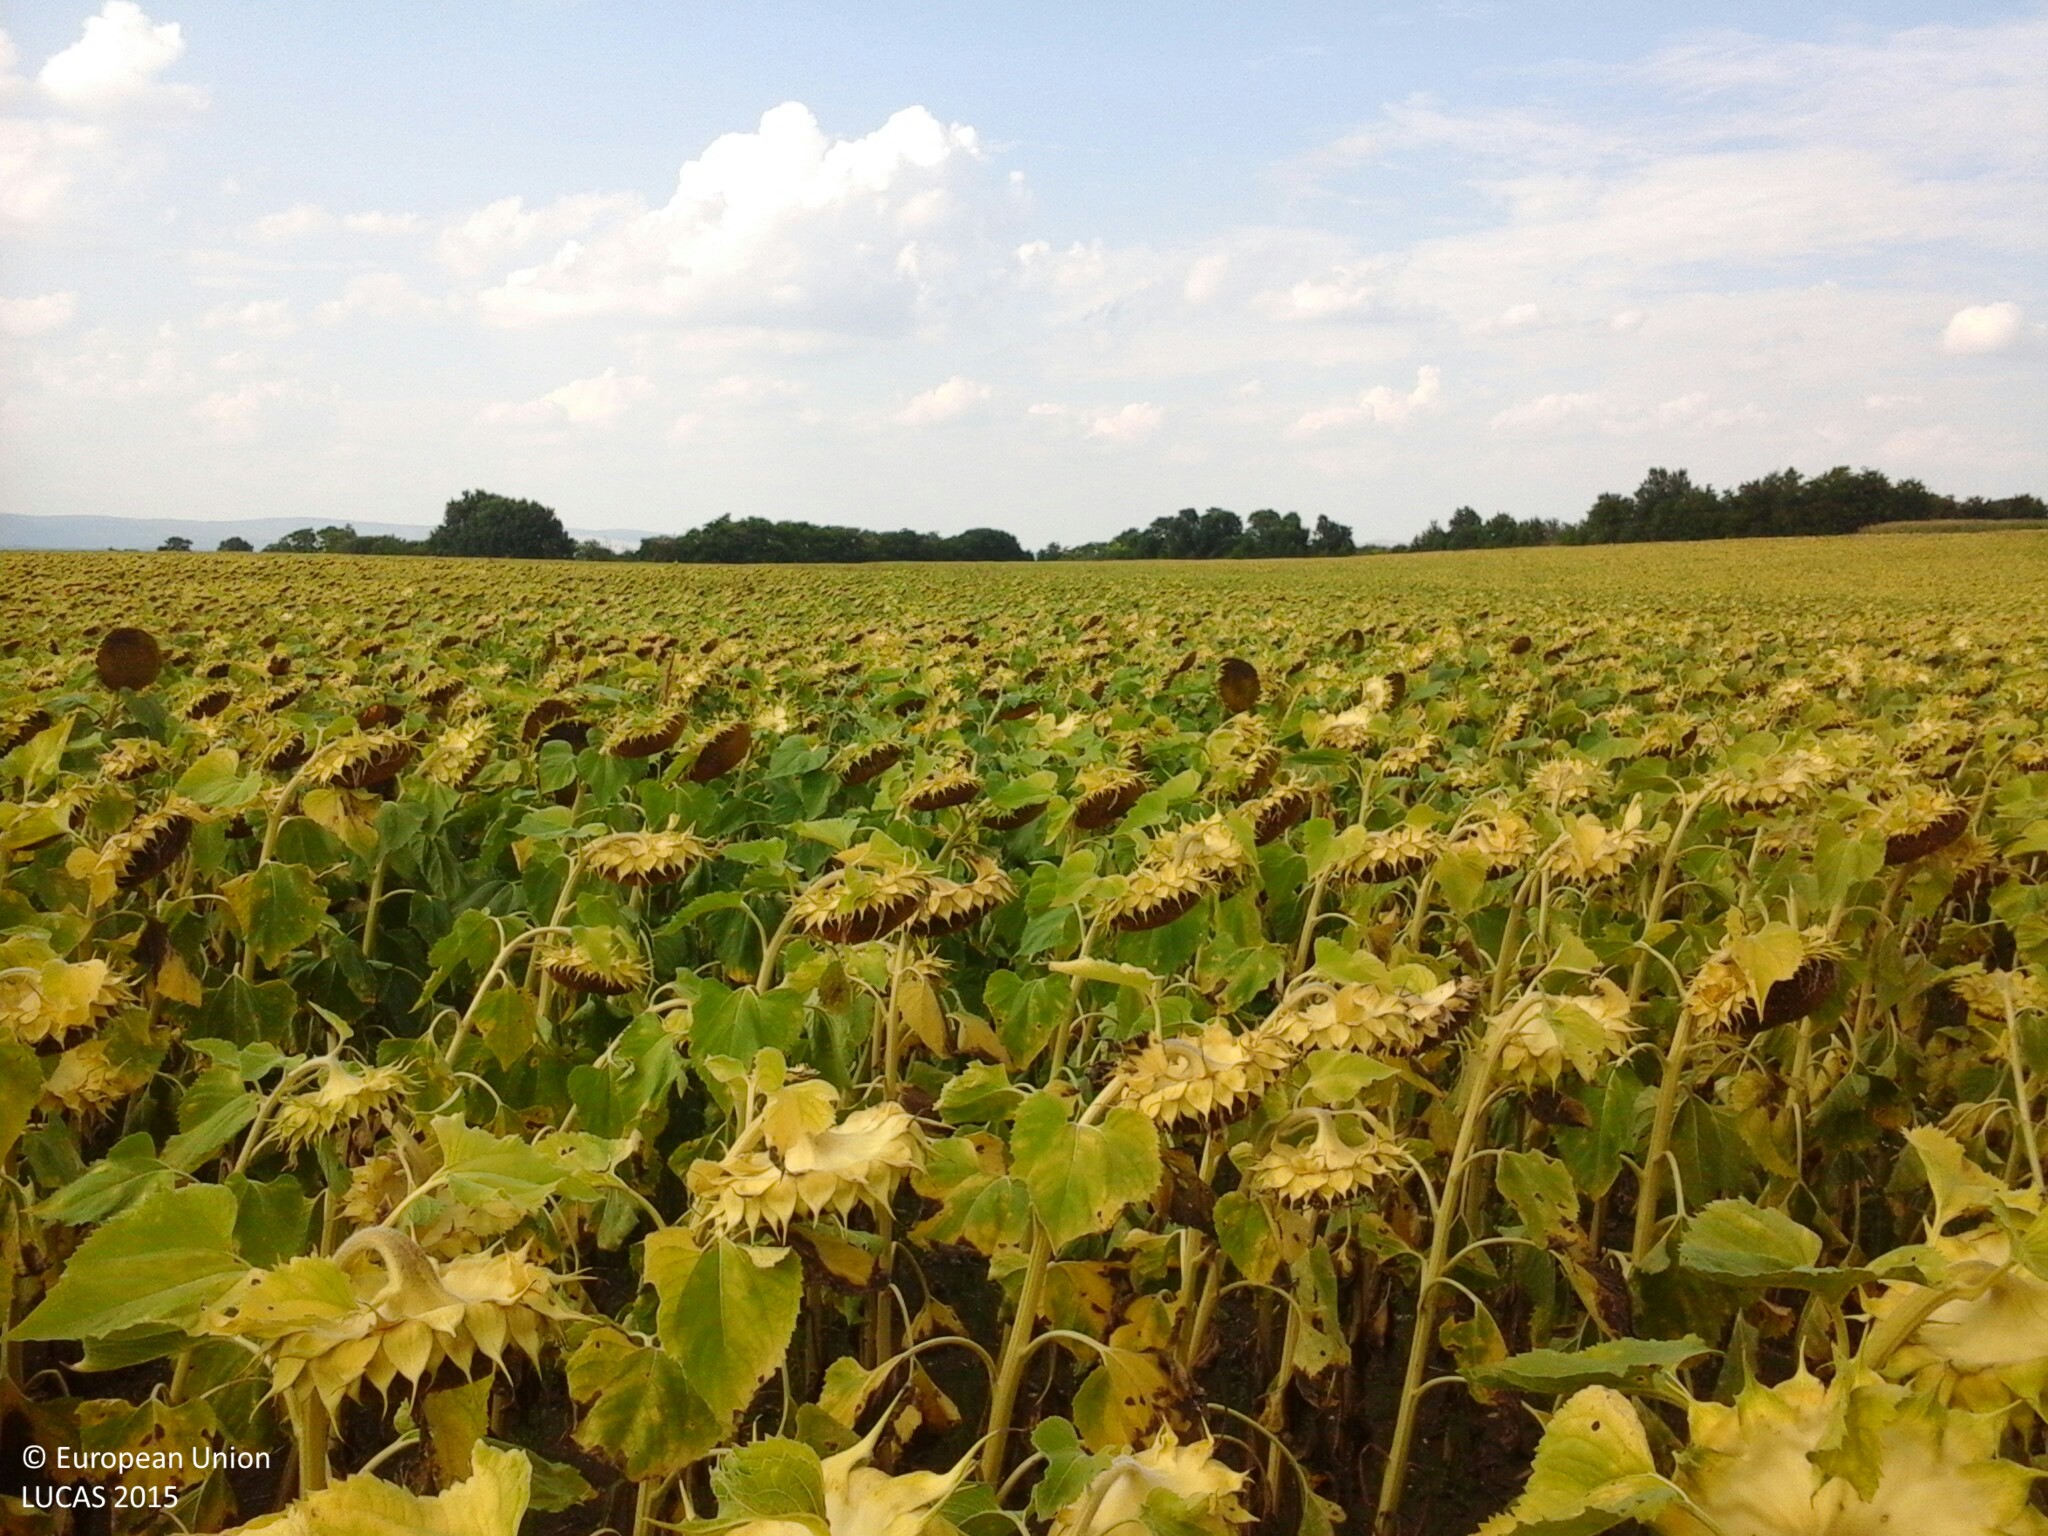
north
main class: Cropland
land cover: Sunflower
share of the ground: > 75 %
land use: Agriculture (excluding fallow land and kitchen gardens)
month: August
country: HU
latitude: 47.0903
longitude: 18.1381
